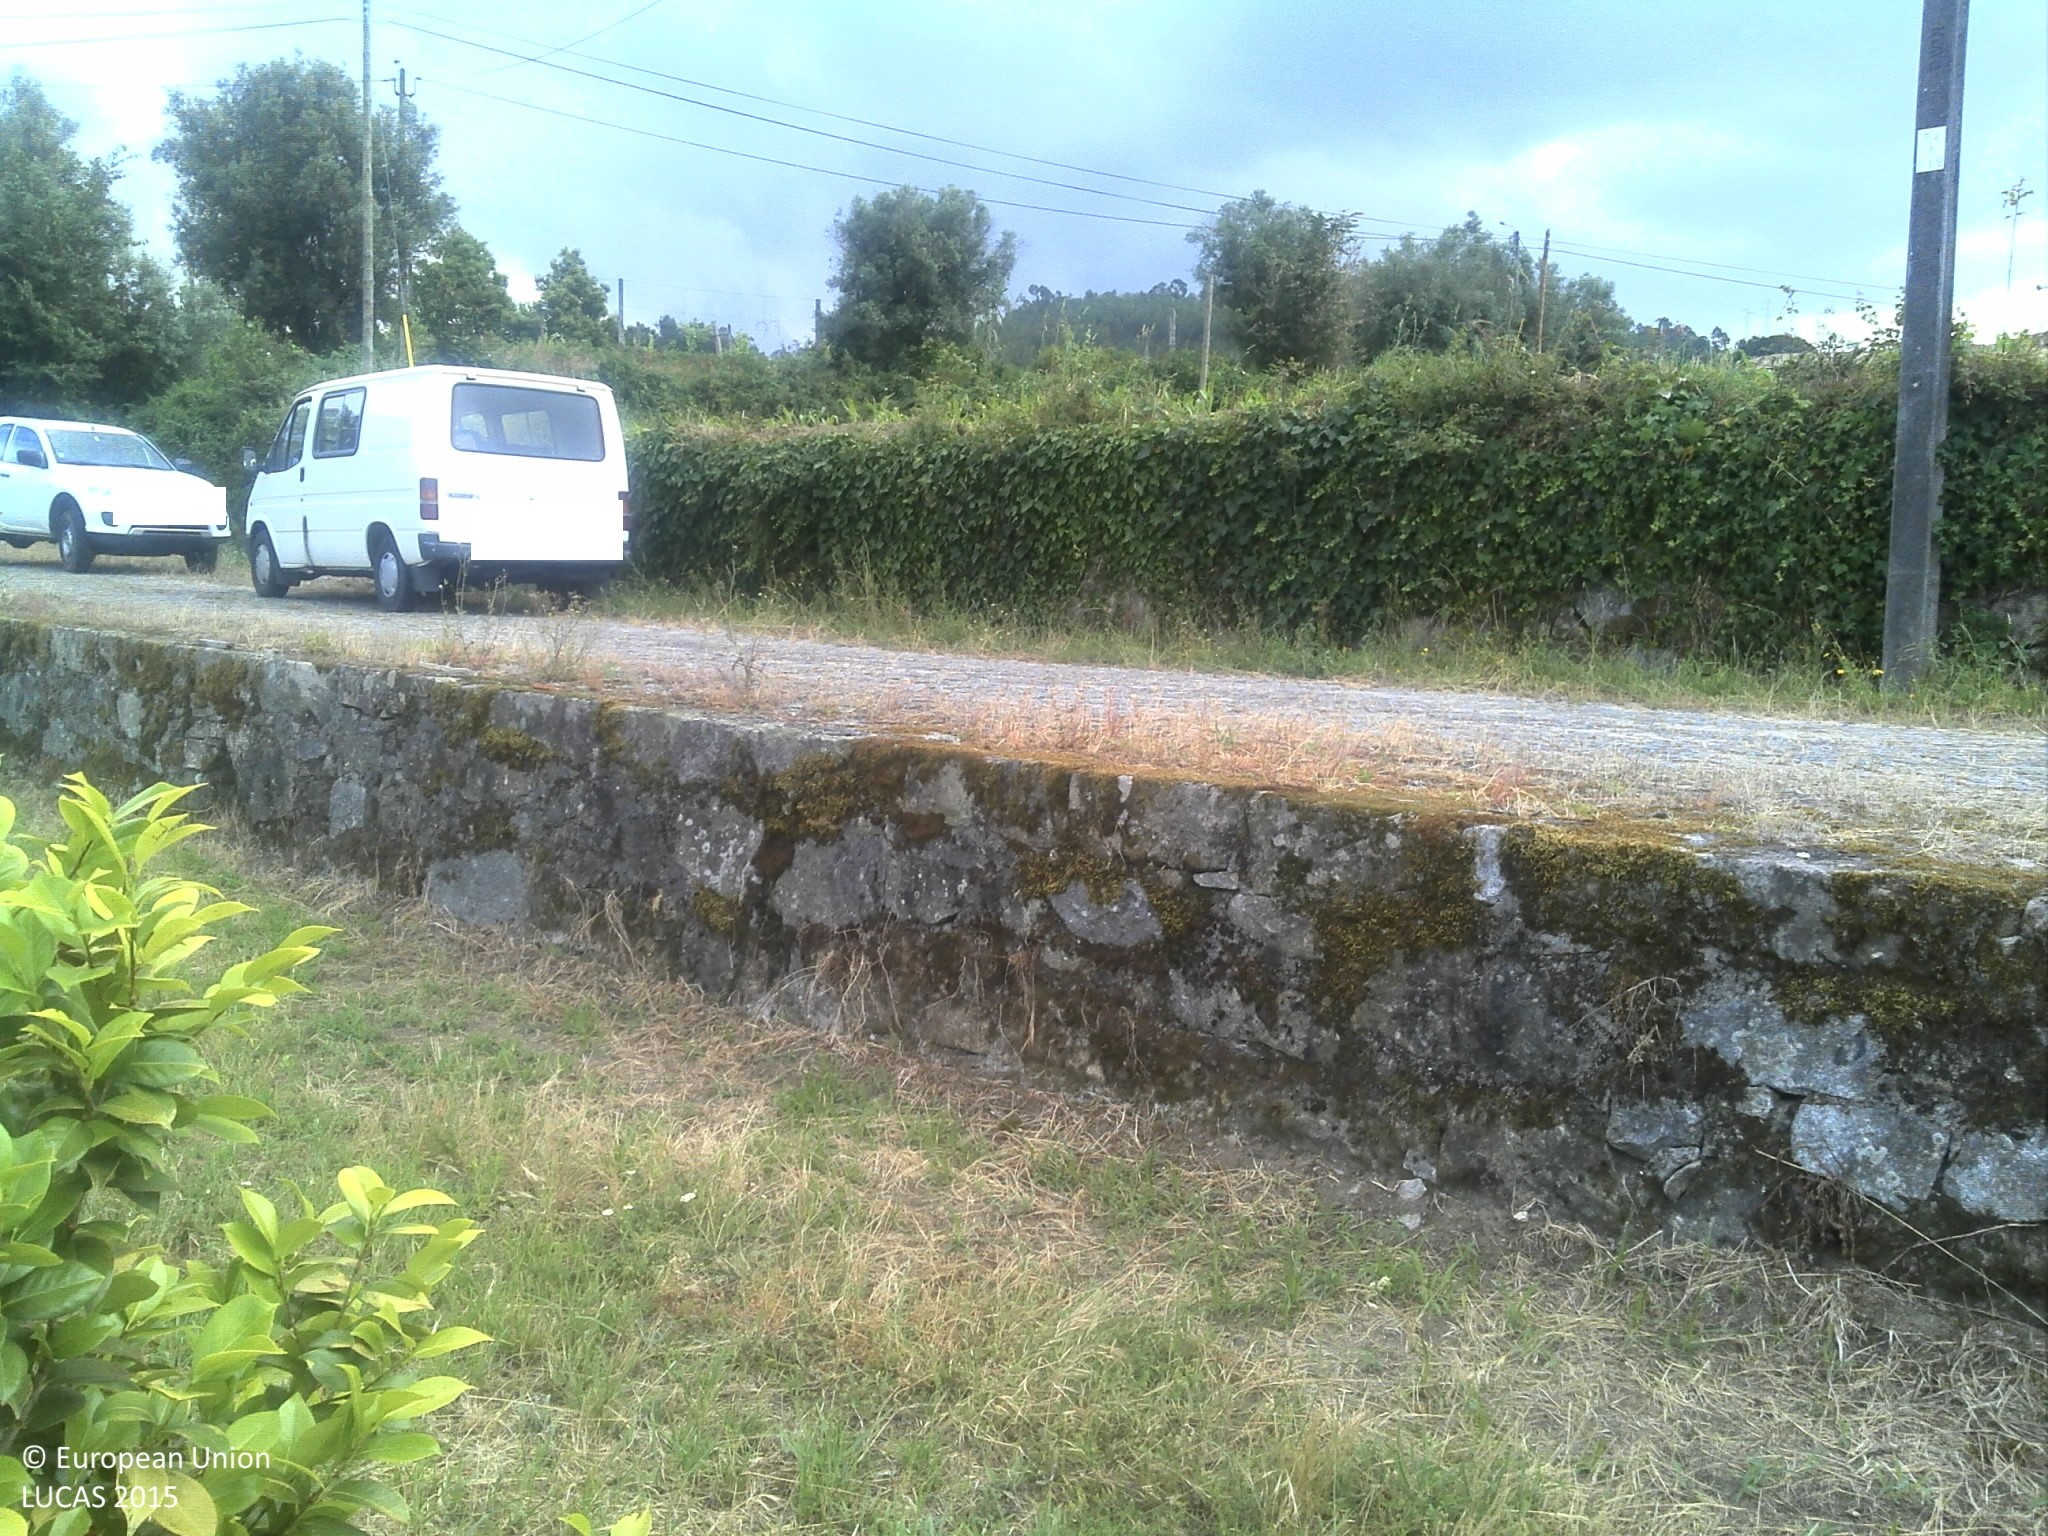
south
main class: Grassland
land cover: Grassland with sparse tree/shrub cover
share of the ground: 50 - 75 %
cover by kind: herbaceous plants 70 %, unconsolidated bare surface 20 %, broadleaved forest trees 5 %, shrubs 5 %
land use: Agriculture (excluding fallow land and kitchen gardens)
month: June
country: PT
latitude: 41.6104
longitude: -8.3319
